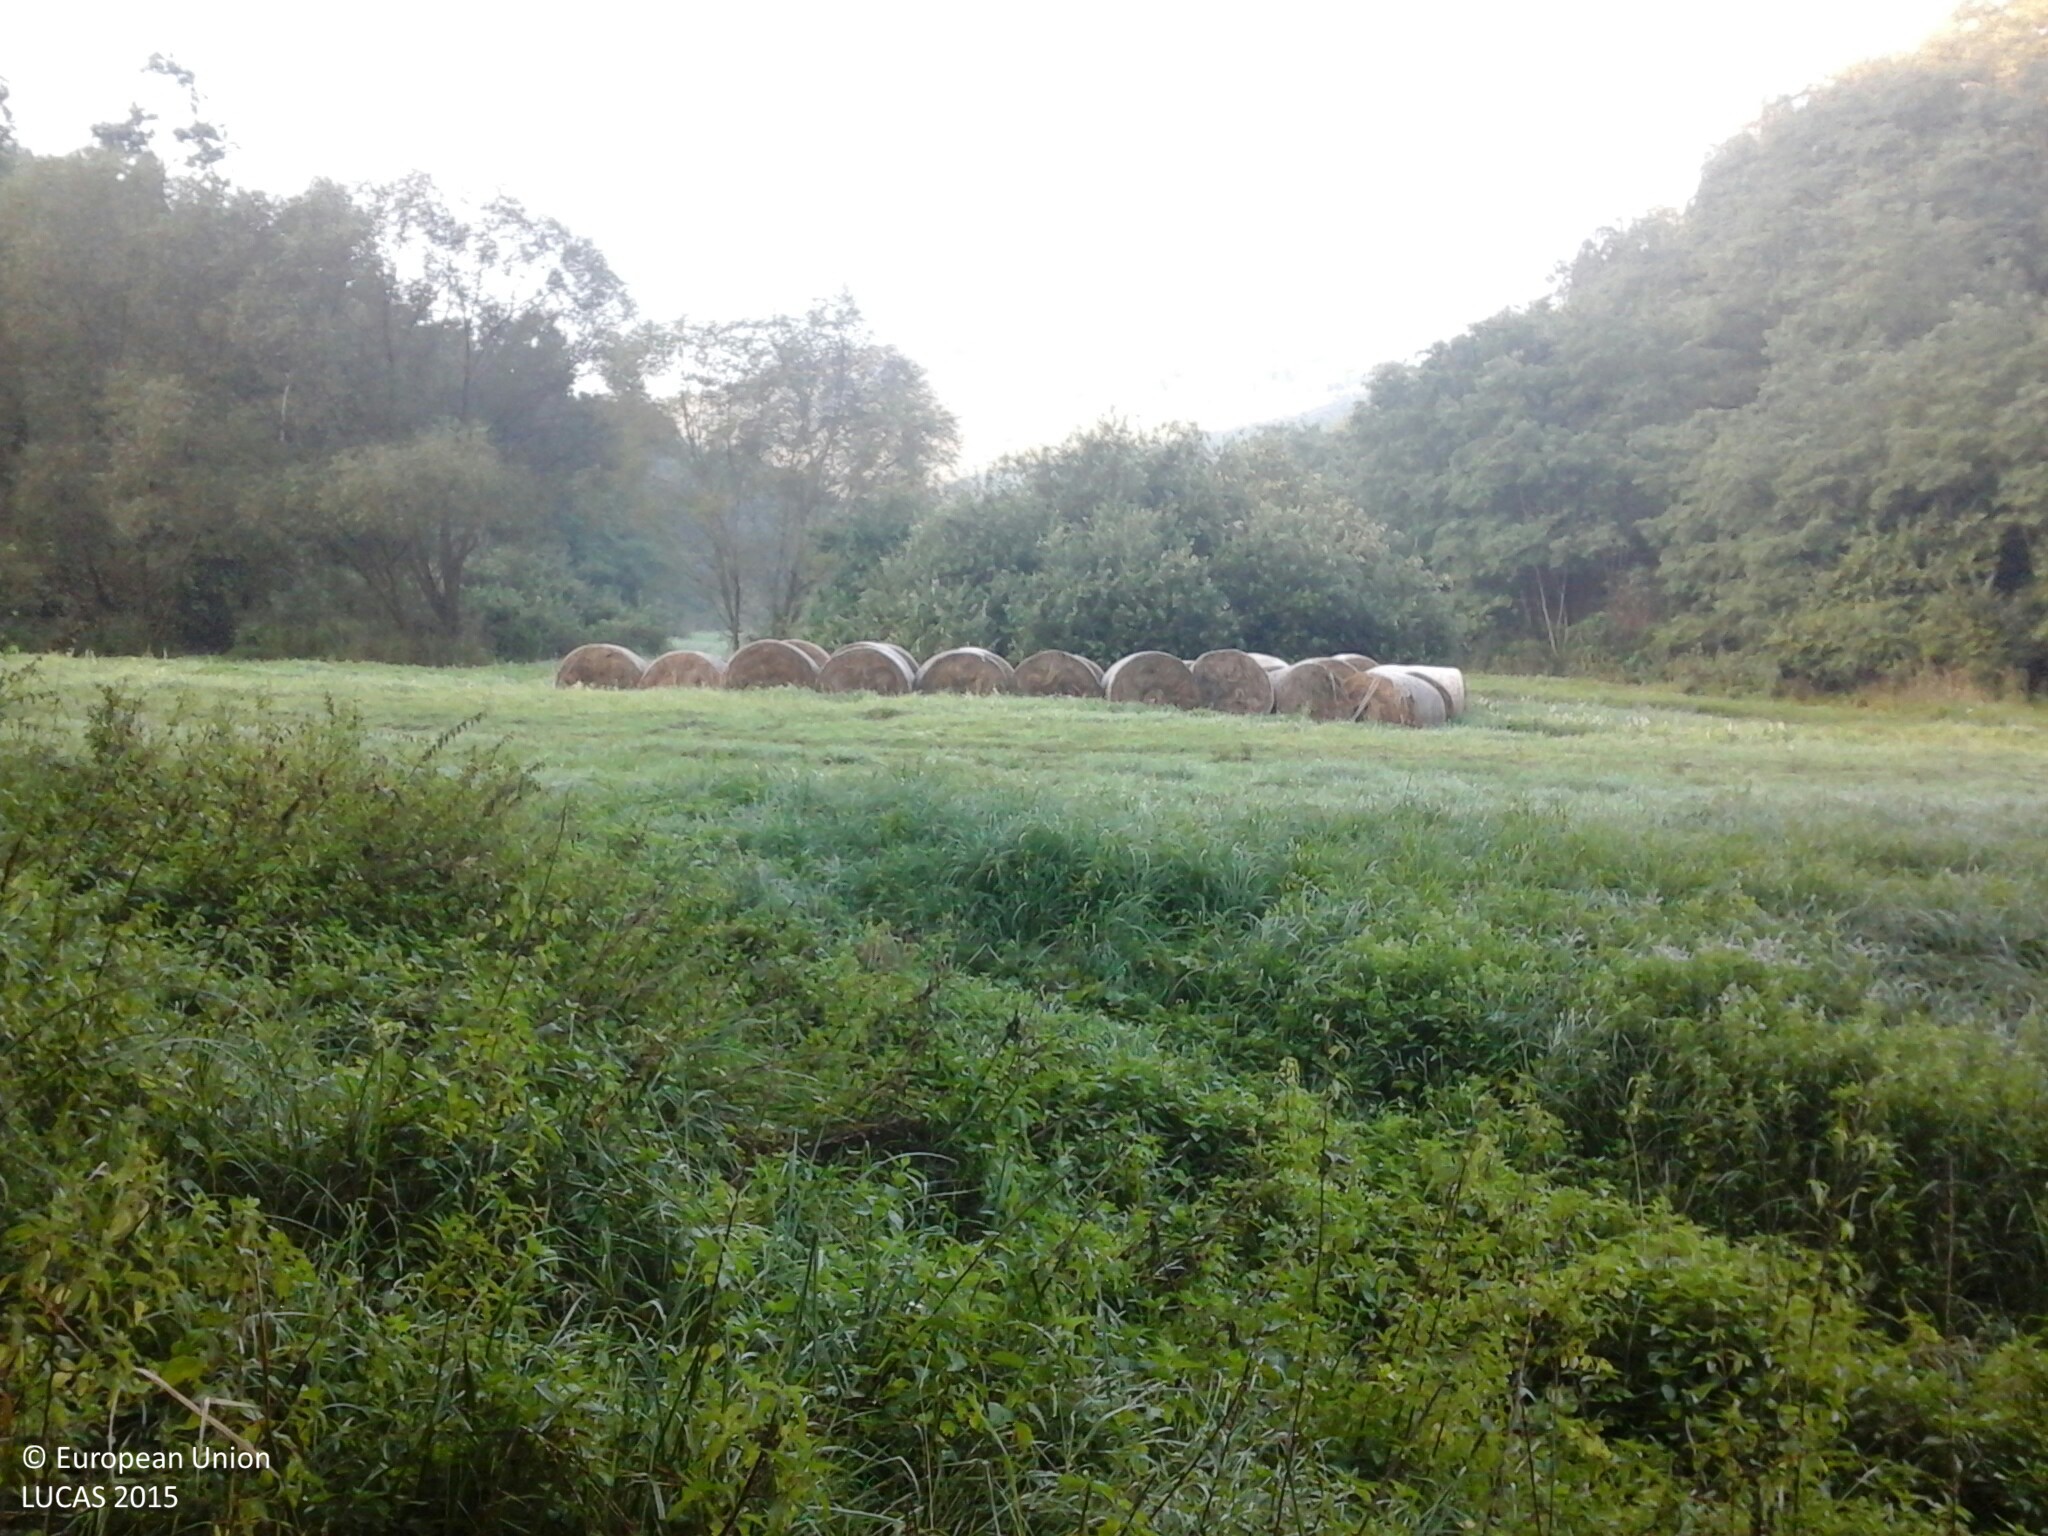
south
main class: Woodland
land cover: Broadleaved woodland
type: mesophytic deciduous forest
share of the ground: > 75 %
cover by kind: broadleaved forest trees 90 %, herbaceous plants 10 %
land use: Forestry
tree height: > 5 m
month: September
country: HU
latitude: 48.1422
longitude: 20.0684
